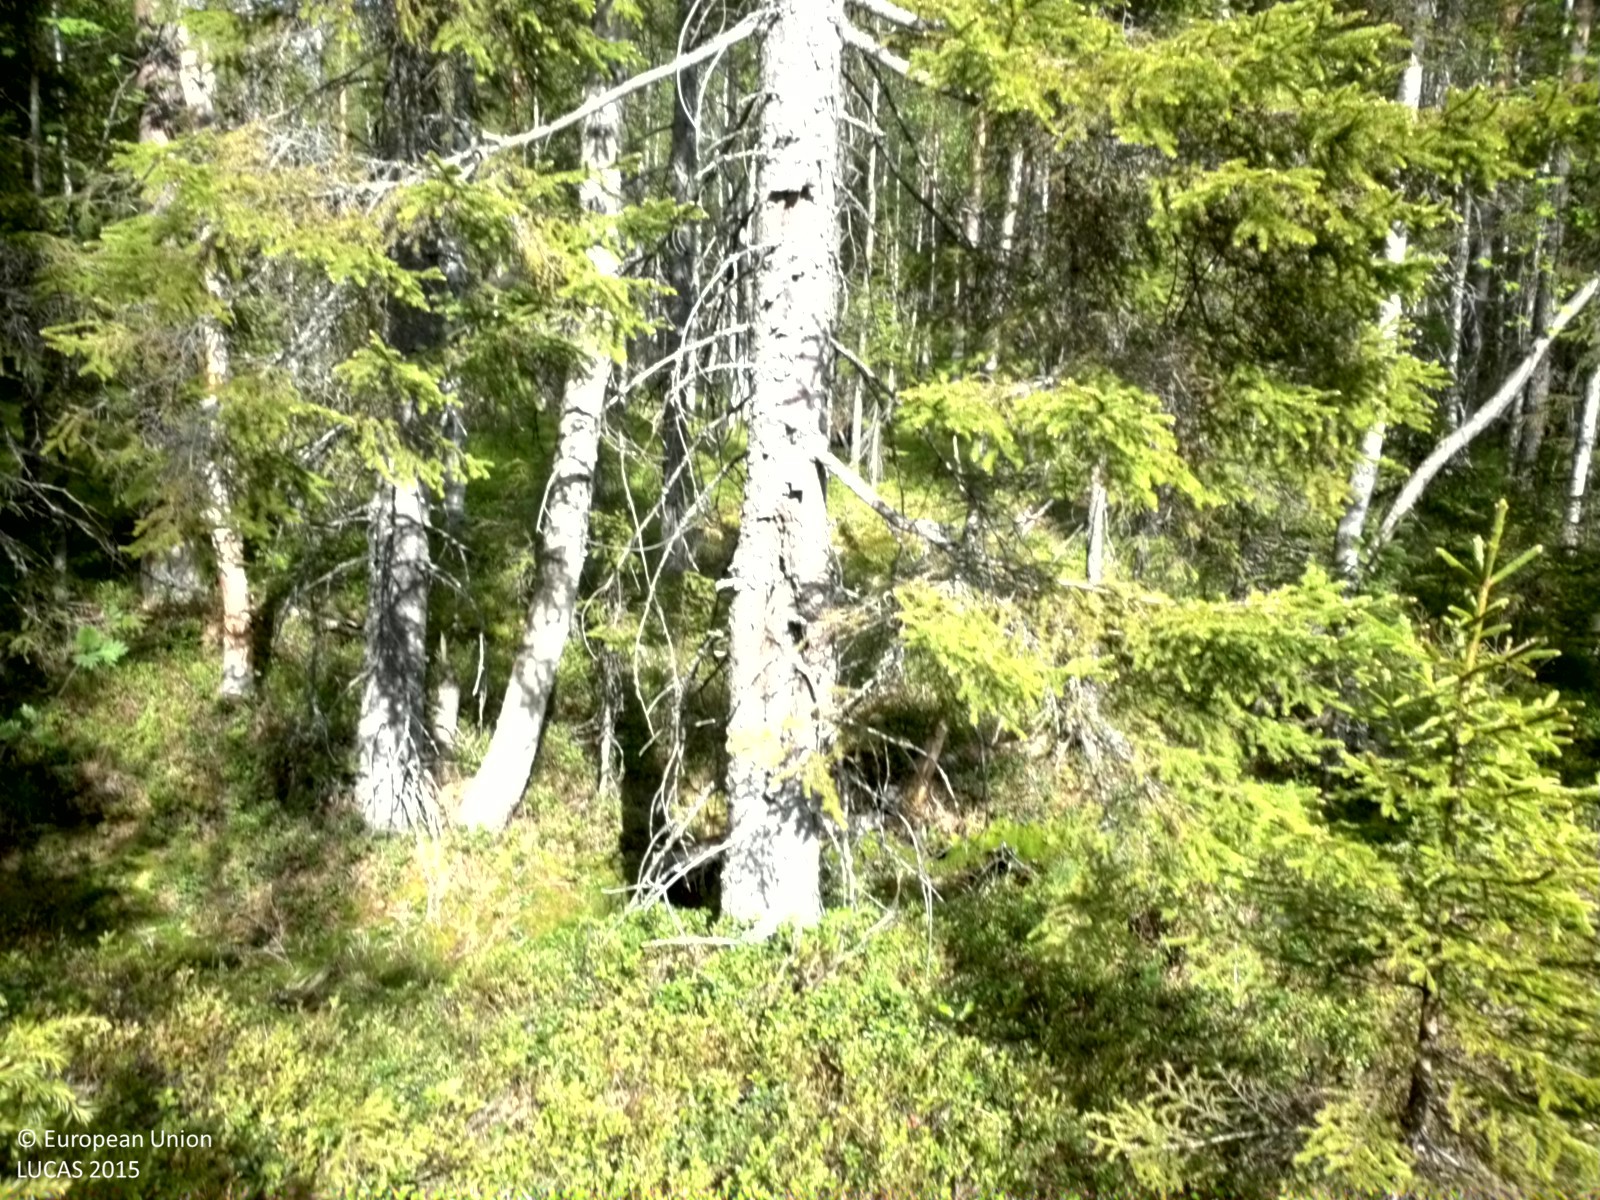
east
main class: Woodland
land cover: Spruce dominated mixed woodland
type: boreal forest
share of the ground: 50 - 75 %
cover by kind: herbaceous plants 50 %, coniferous forest trees 30 %, broadleaved forest trees 20 %
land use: Forestry
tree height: > 5 m
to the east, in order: Spruce dominated mixed woodland; Rivers and streams; Other mixed woodland; Spruce dominated mixed woodland; Tracks; Abandoned hedges; Ditches and canals; Spruce dominated mixed woodland; Other mixed woodland; Pine dominated mixed woodland
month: June
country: SE
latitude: 63.9490
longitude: 20.0819
